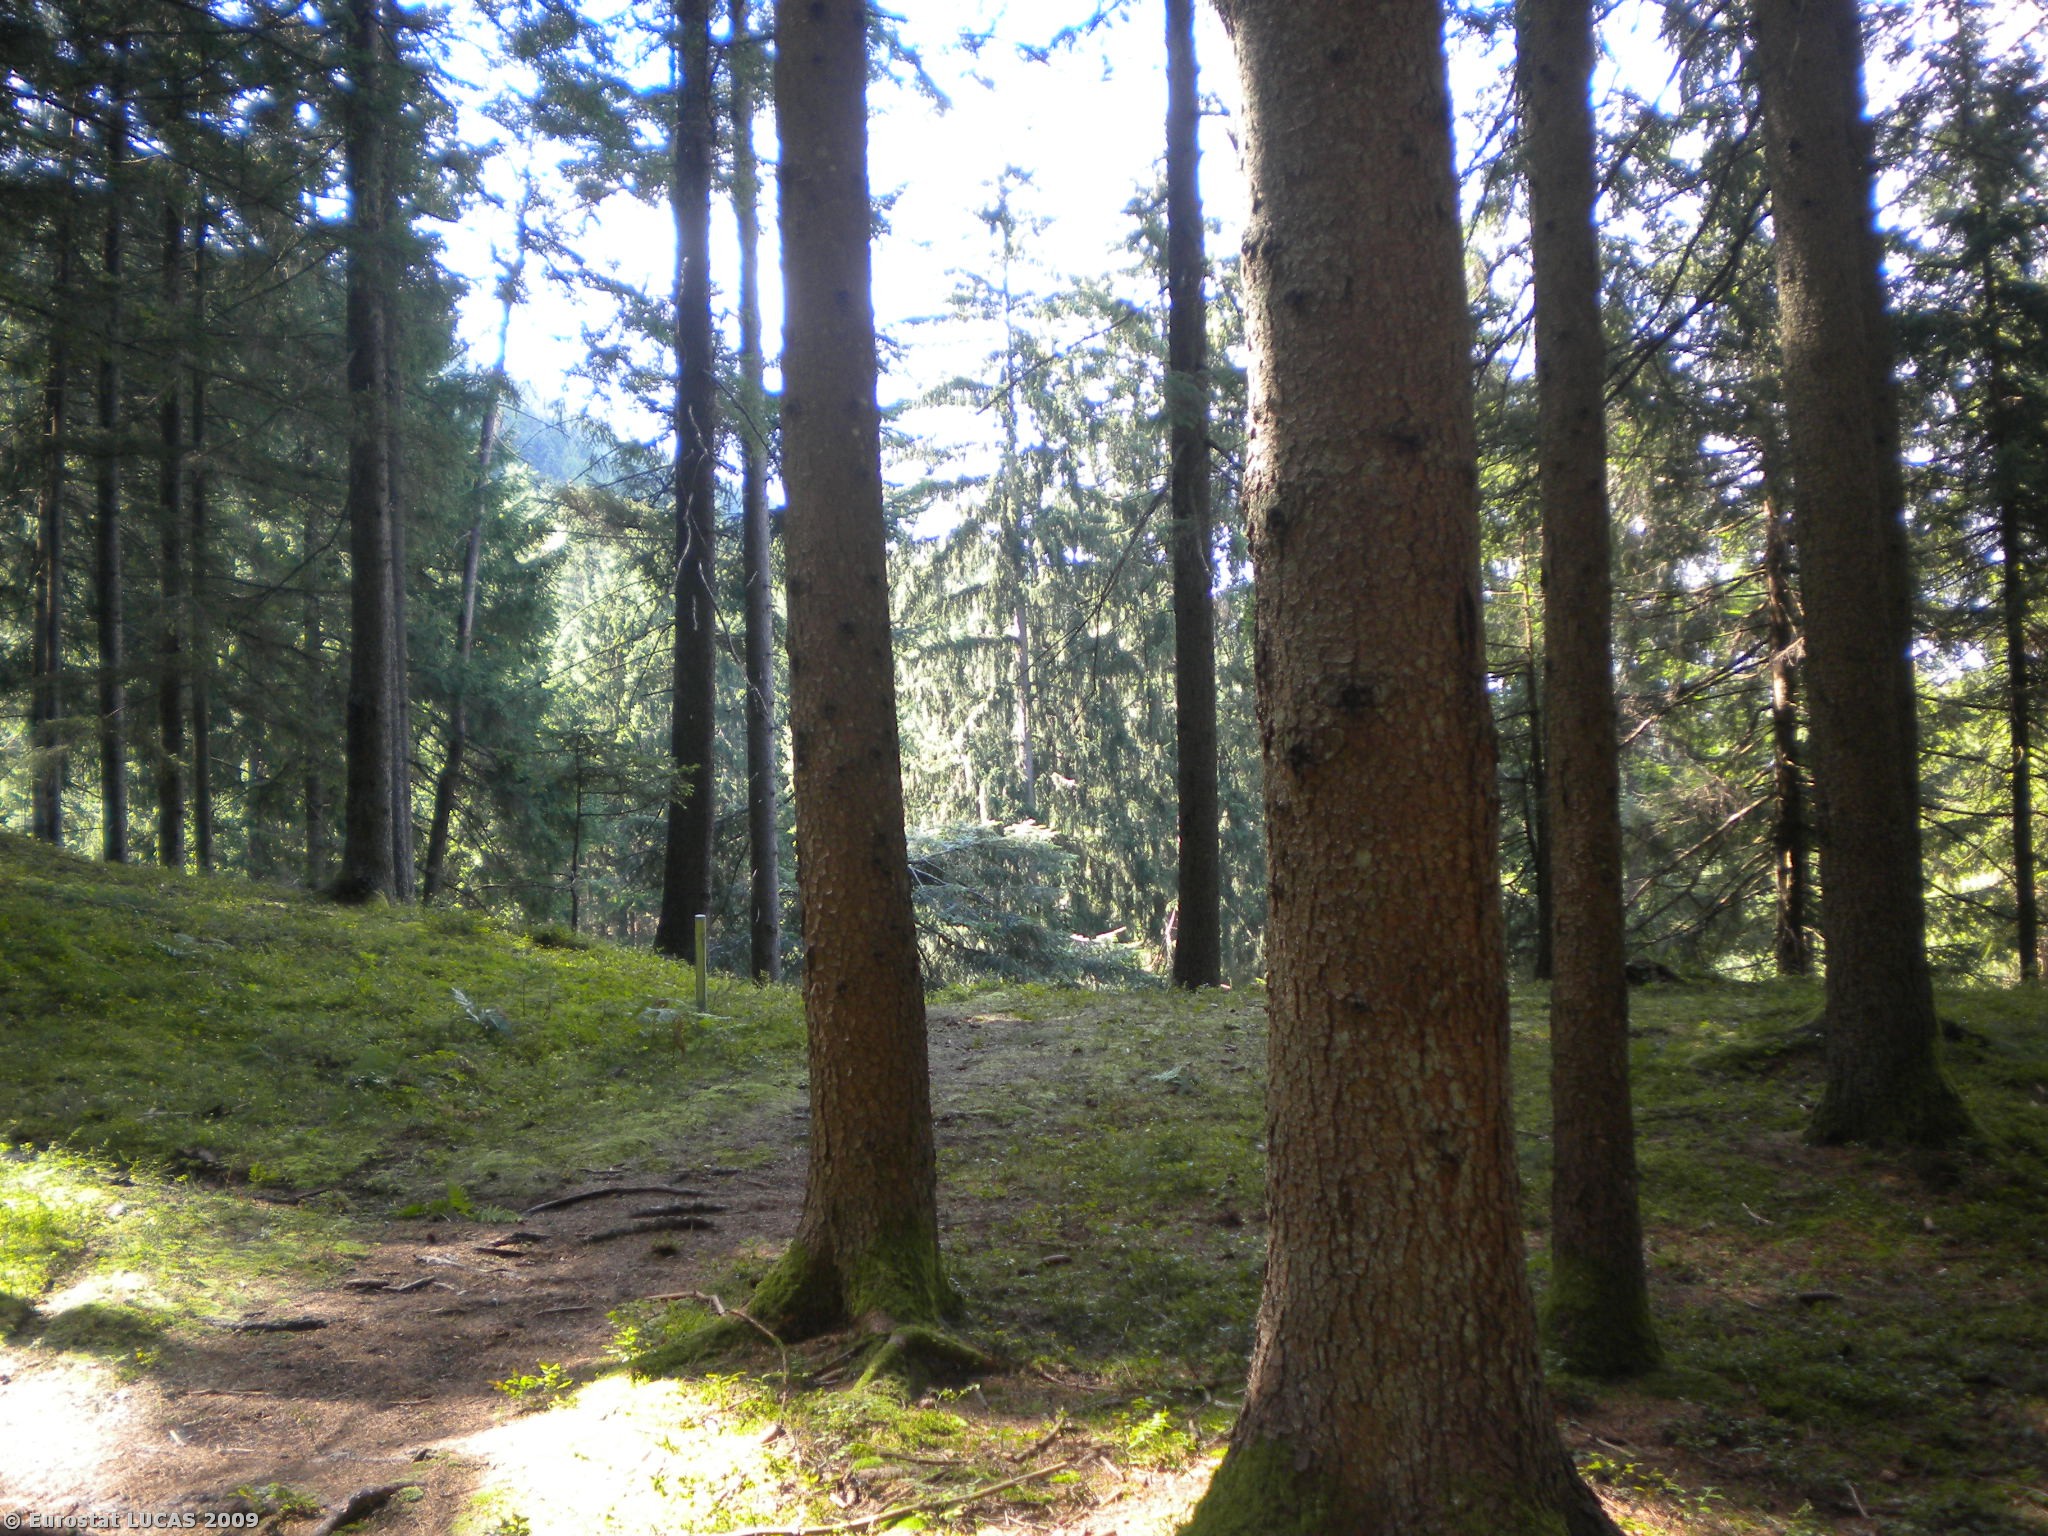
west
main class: Woodland
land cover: Coniferous woodland
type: alpine coniferous forest
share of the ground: > 75 %
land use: Forestry
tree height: > 5 m
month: August
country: AT
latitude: 46.8005
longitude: 13.4434
